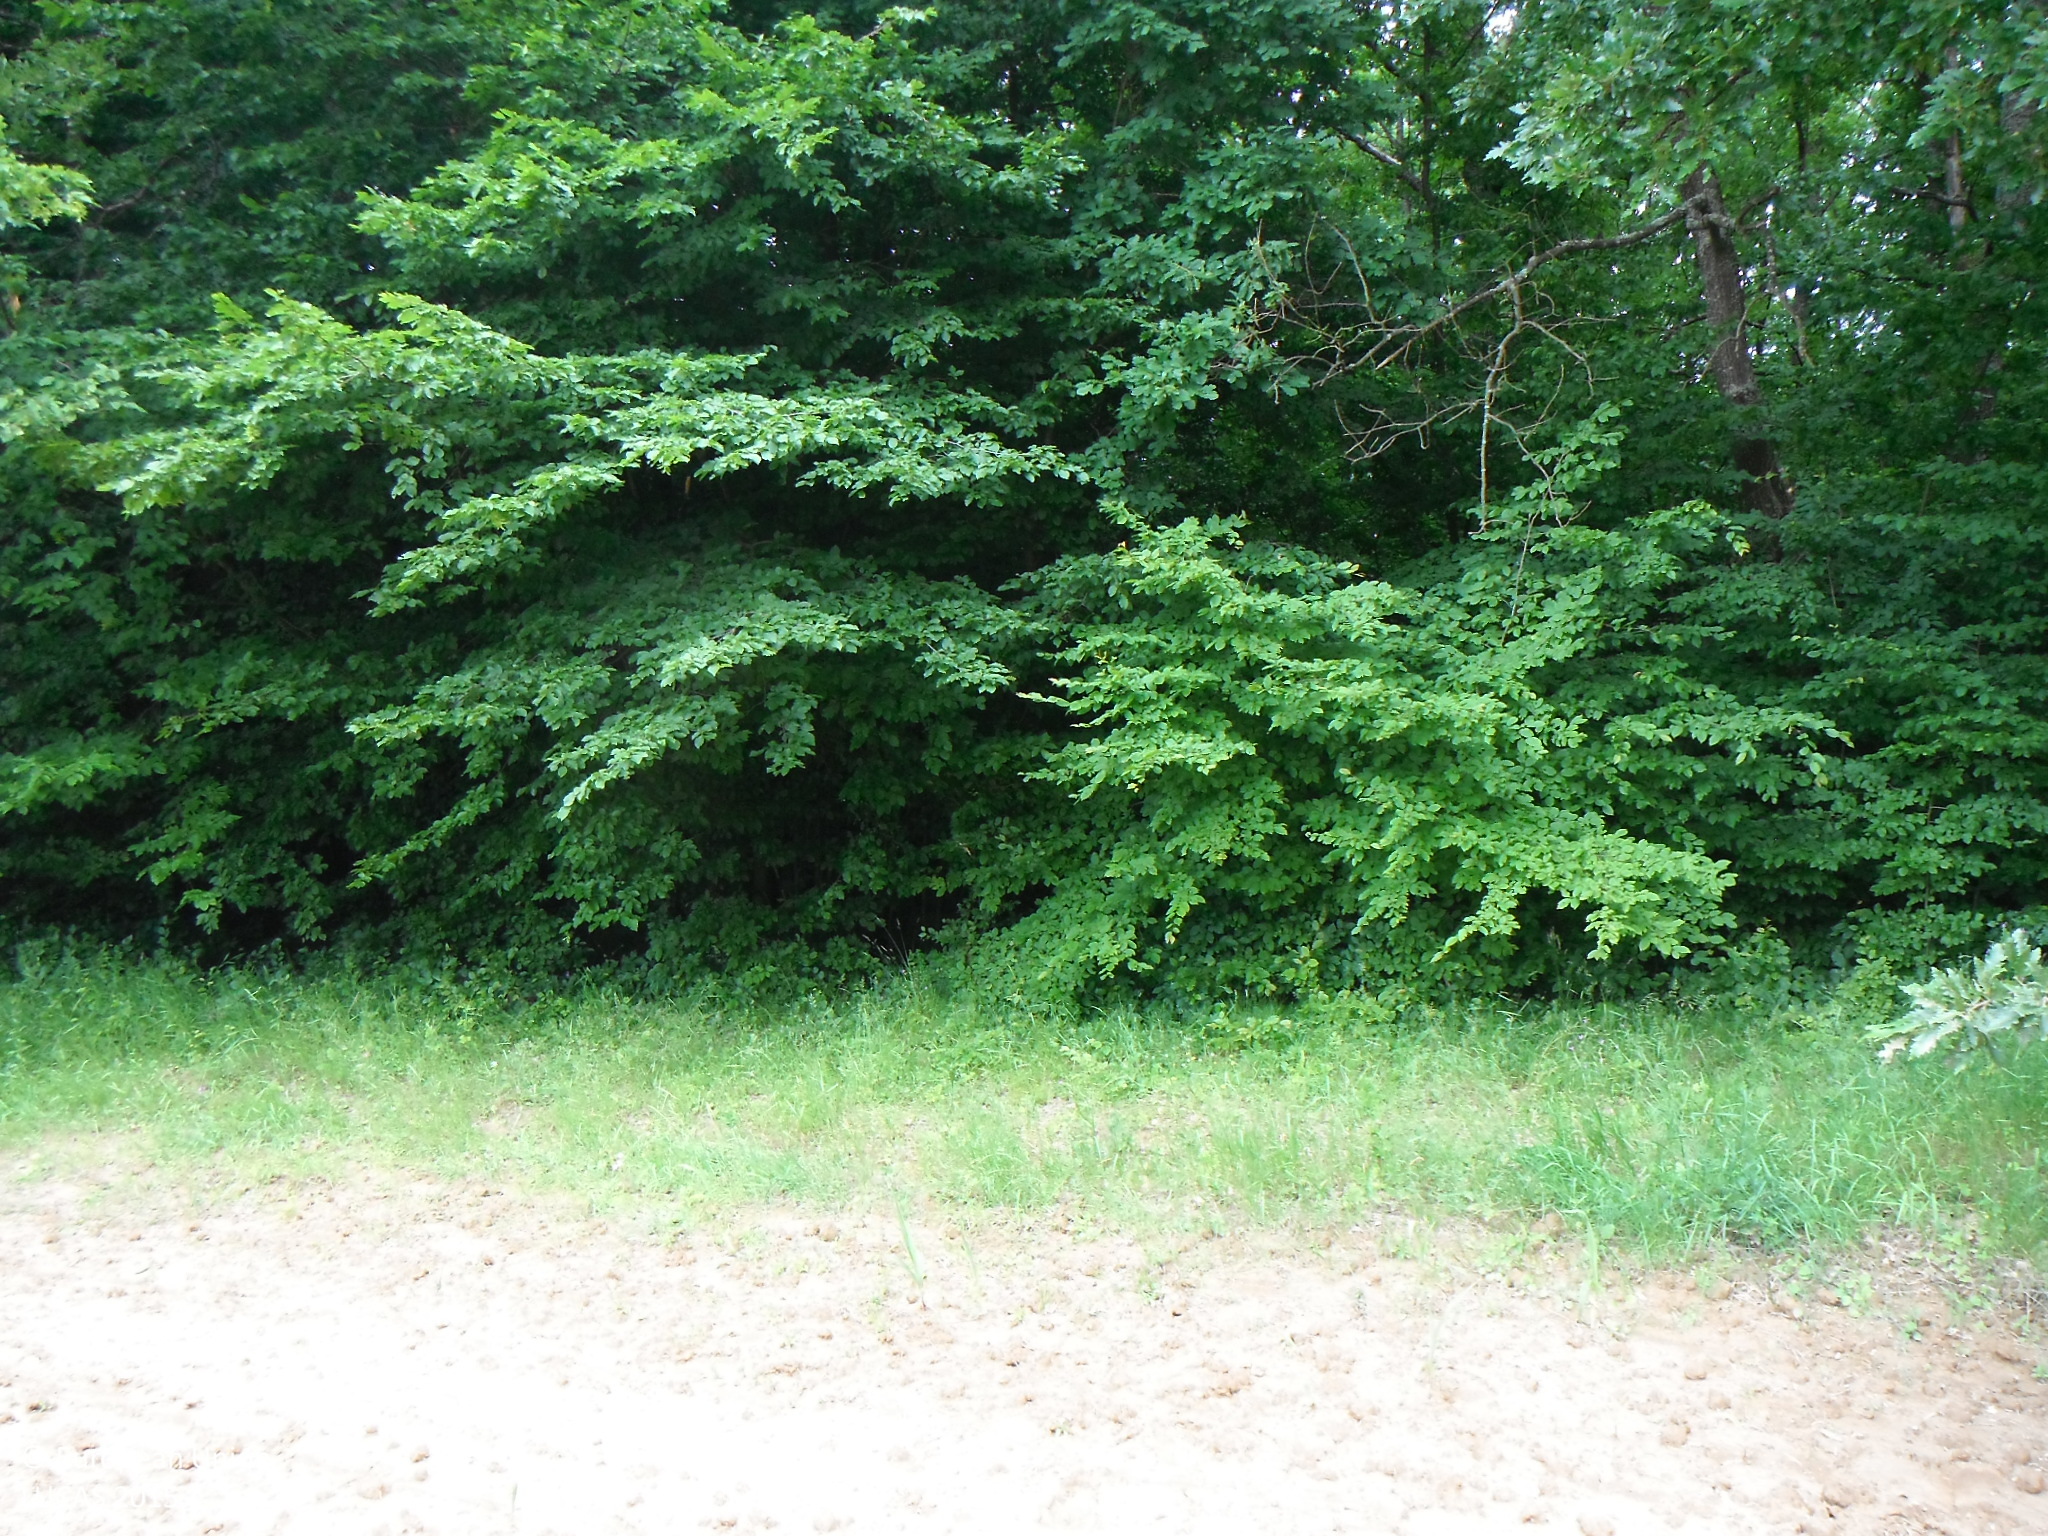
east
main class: Cropland
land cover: Maize
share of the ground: < 10 %
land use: Agriculture (excluding fallow land and kitchen gardens)
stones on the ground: < 10 %
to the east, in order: Maize; Broadleaved woodland
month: June
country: SK
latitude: 48.4644
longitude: 19.9148
